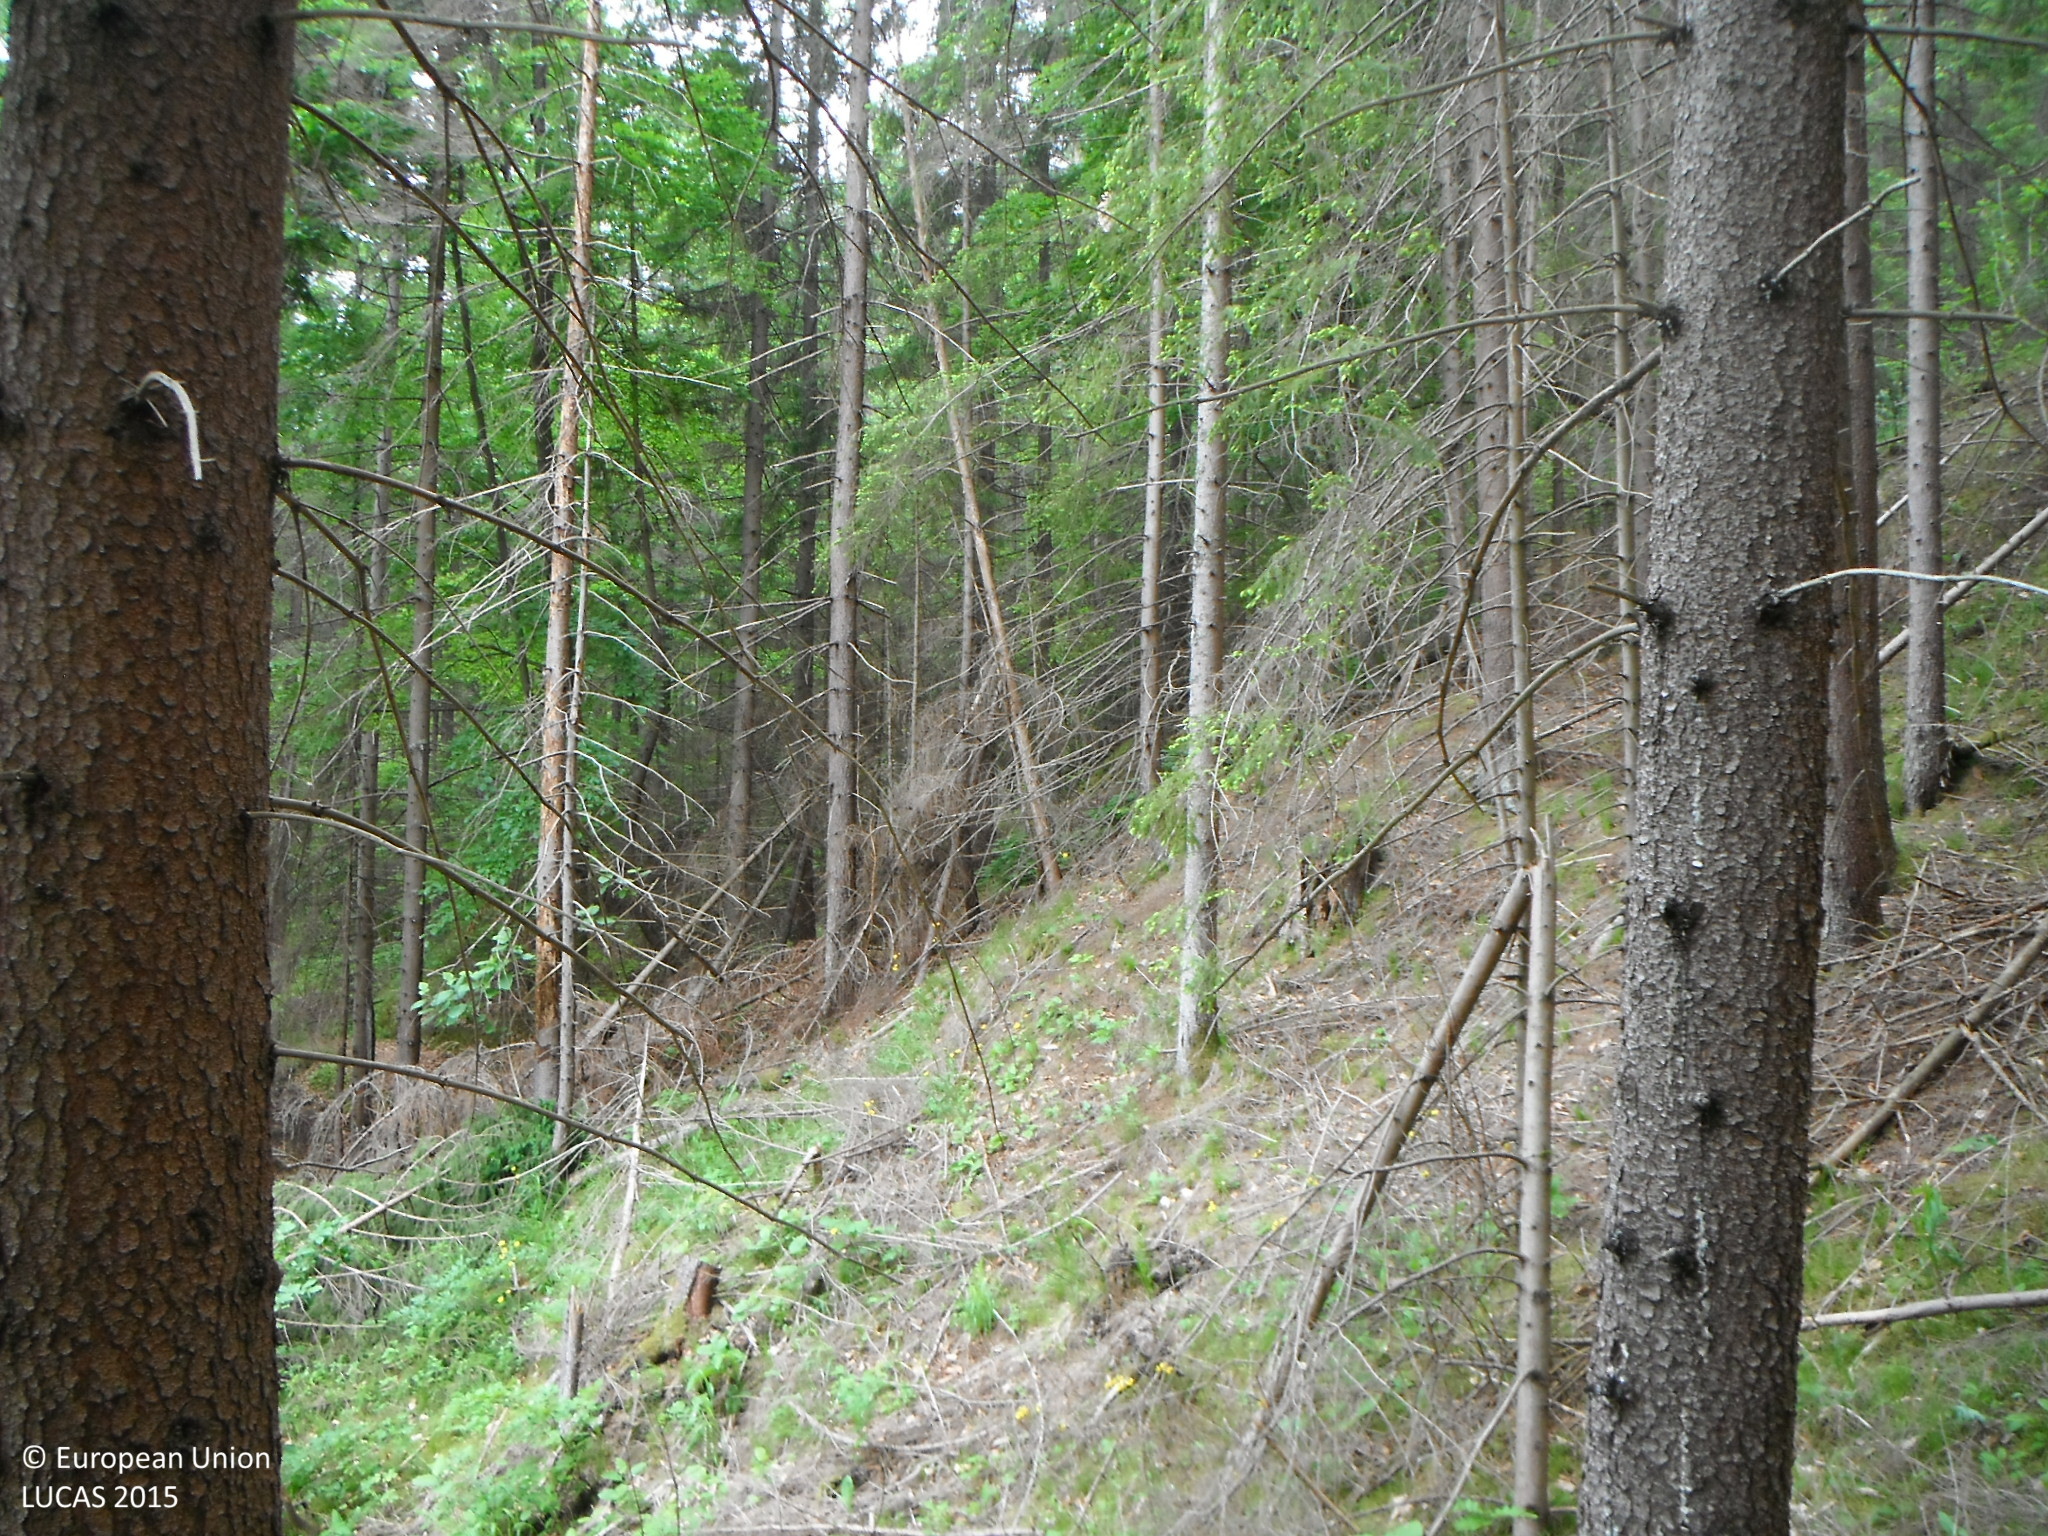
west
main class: Woodland
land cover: Spruce dominated coniferous woodland
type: alpine coniferous forest
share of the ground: > 75 %
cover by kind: coniferous forest trees 95 %, broadleaved forest trees 5 %
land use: Forestry
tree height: > 5 m
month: June
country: SK
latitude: 48.7810
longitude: 19.4013
